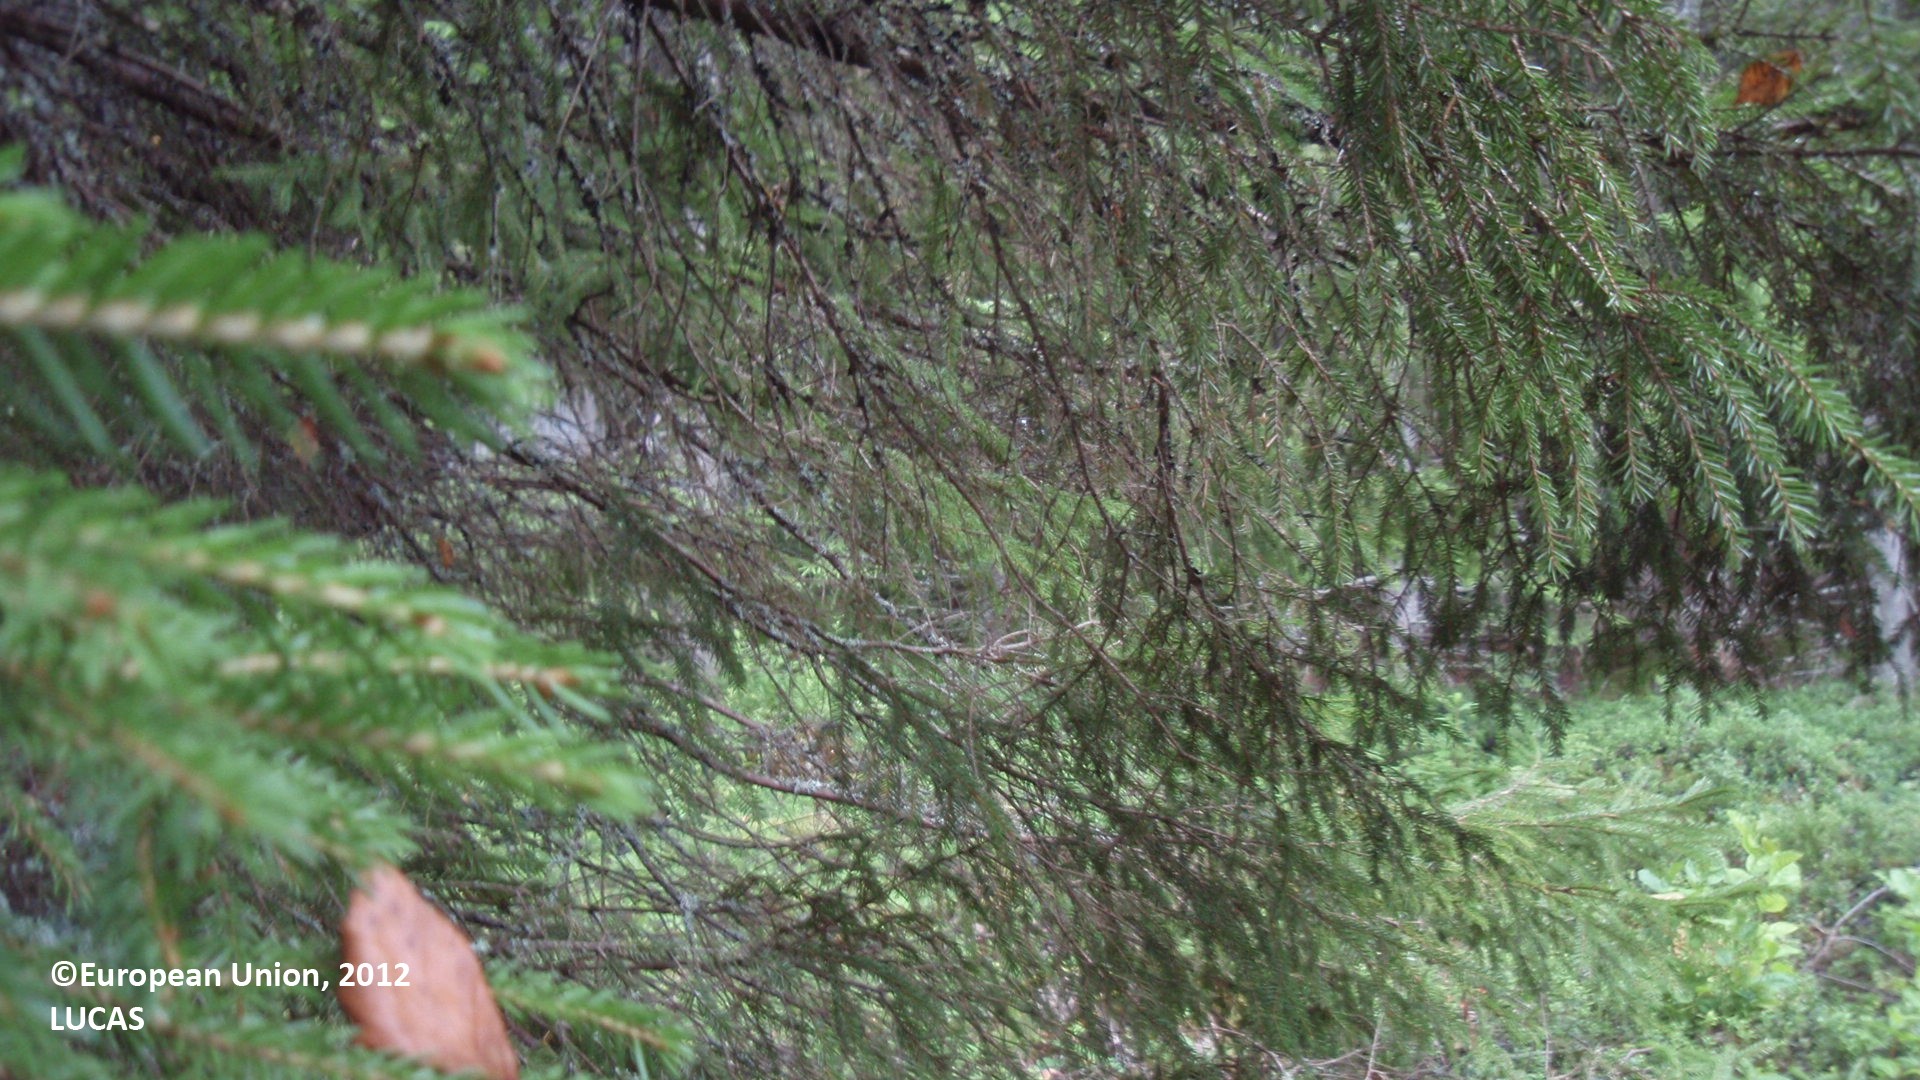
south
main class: Woodland
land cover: Broadleaved woodland
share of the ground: > 75 %
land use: Forestry
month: August
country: FI
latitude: 61.1275
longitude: 27.8098
